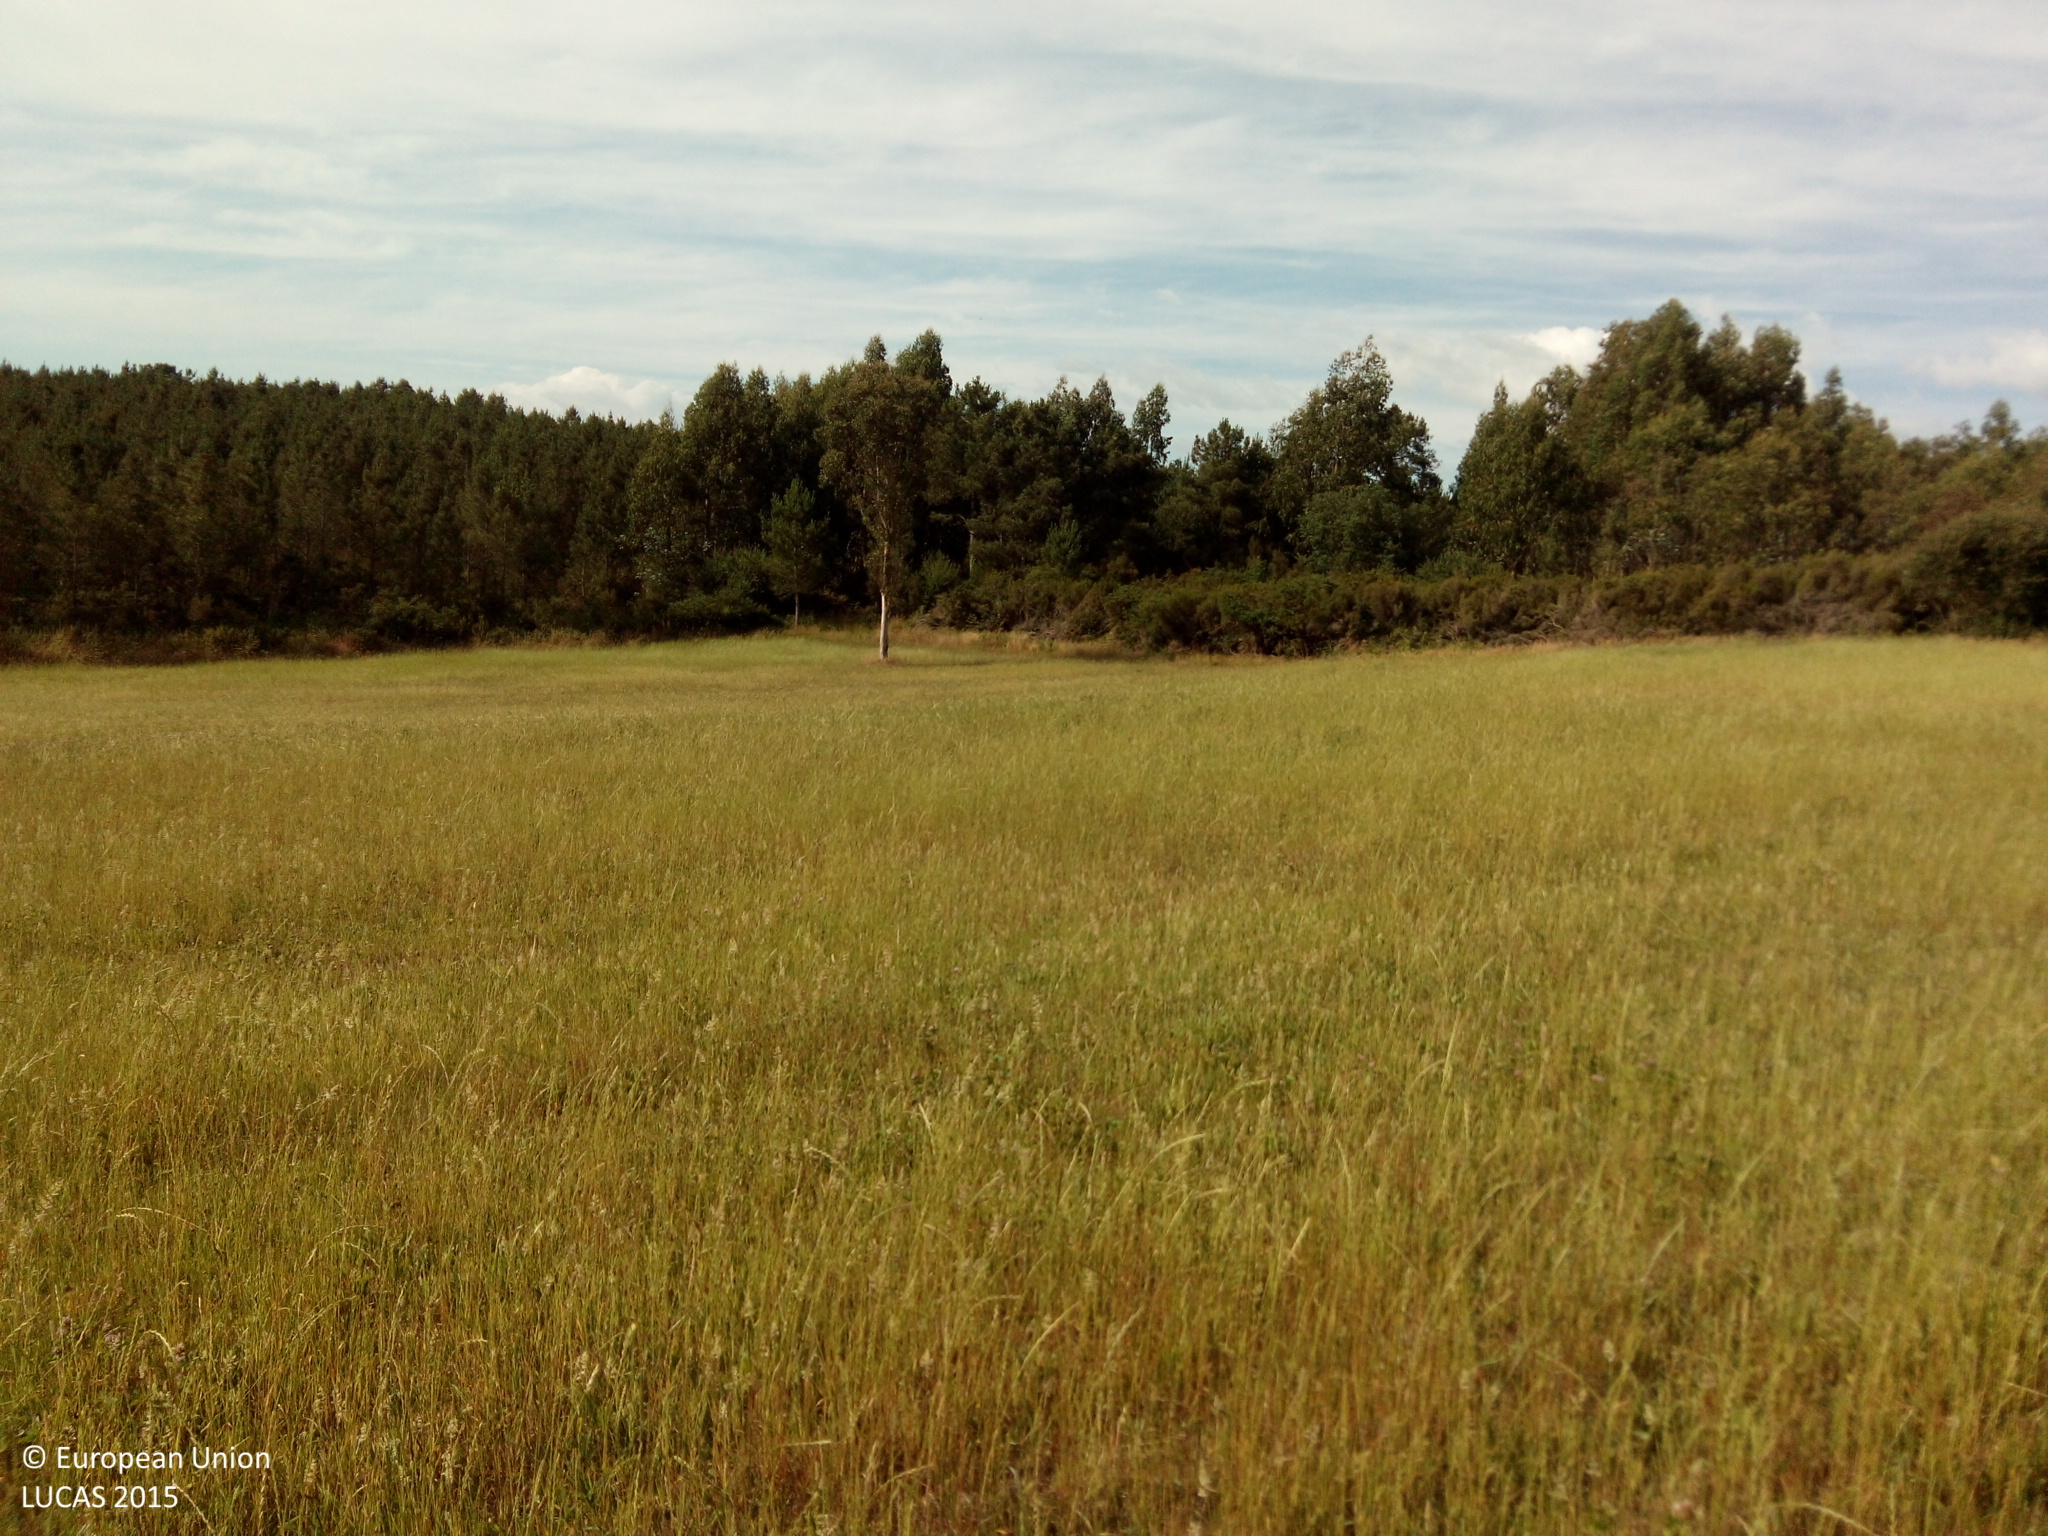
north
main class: Cropland
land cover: Mixed cereals for fodder
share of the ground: > 75 %
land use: Agriculture (excluding fallow land and kitchen gardens)
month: July
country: ES
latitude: 42.8717
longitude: -7.9971
